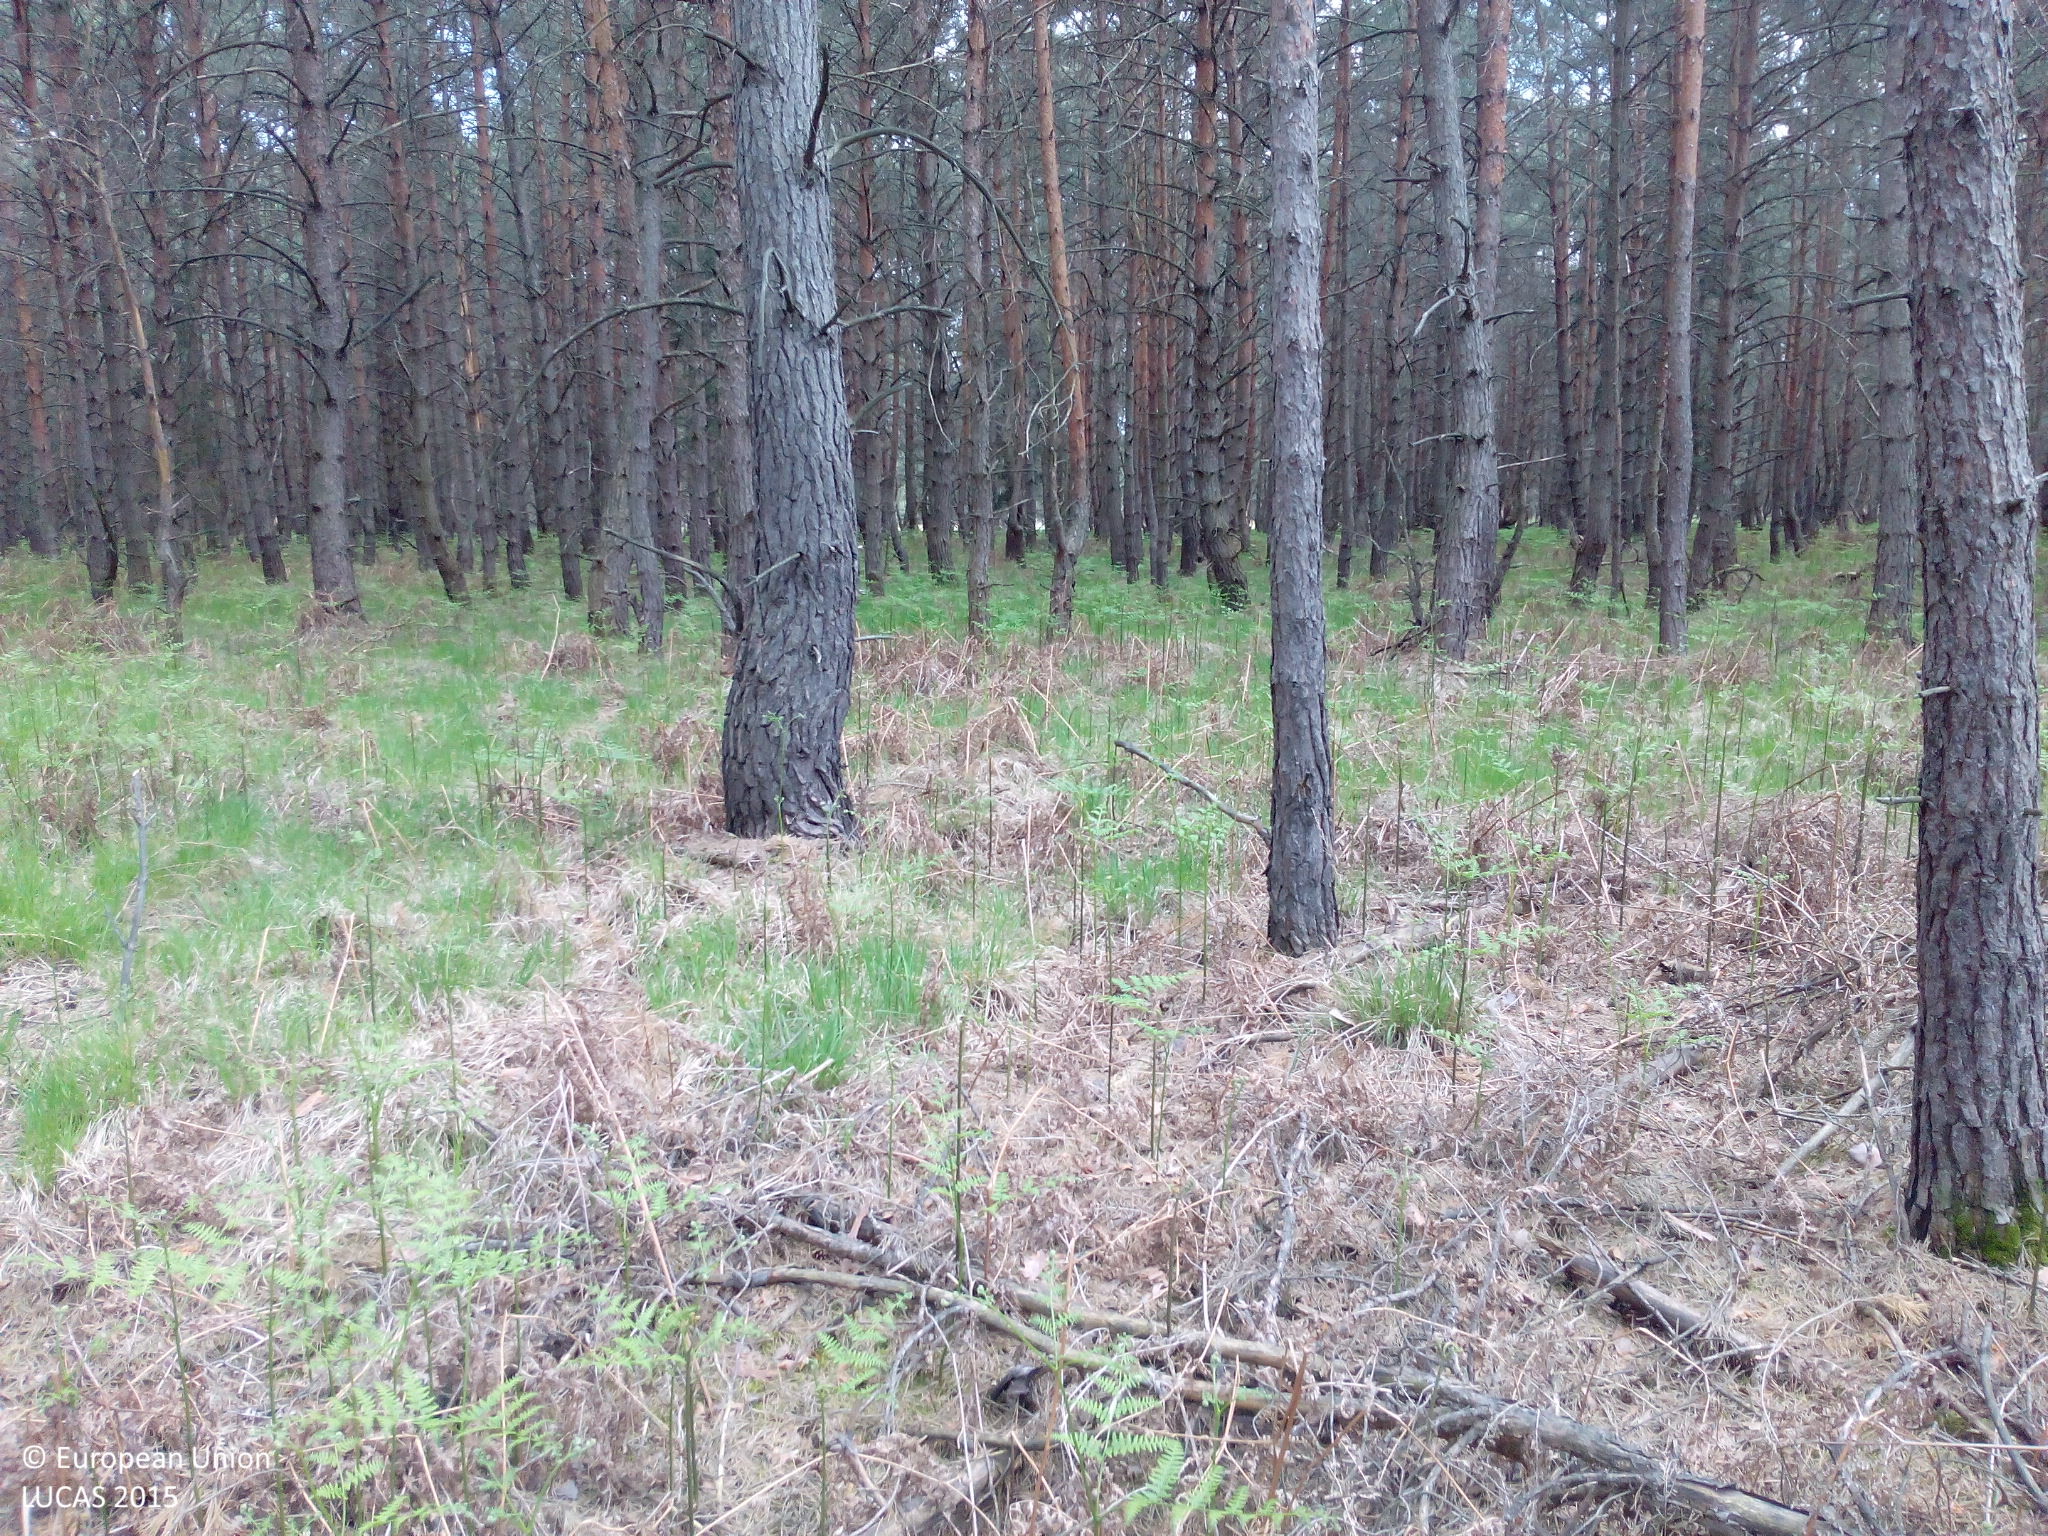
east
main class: Woodland
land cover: Pine dominated coniferous woodland
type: hemiboreal forest and nemoral coniferous forest and mixed broadleaved-coniferous forest
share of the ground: > 75 %
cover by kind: coniferous forest trees 100 %
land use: Forestry
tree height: > 5 m
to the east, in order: Pine dominated coniferous woodland; Grassland with sparse tree/shrub cover; Pine dominated coniferous woodland
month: May
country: DE
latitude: 51.7308
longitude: 13.5478
